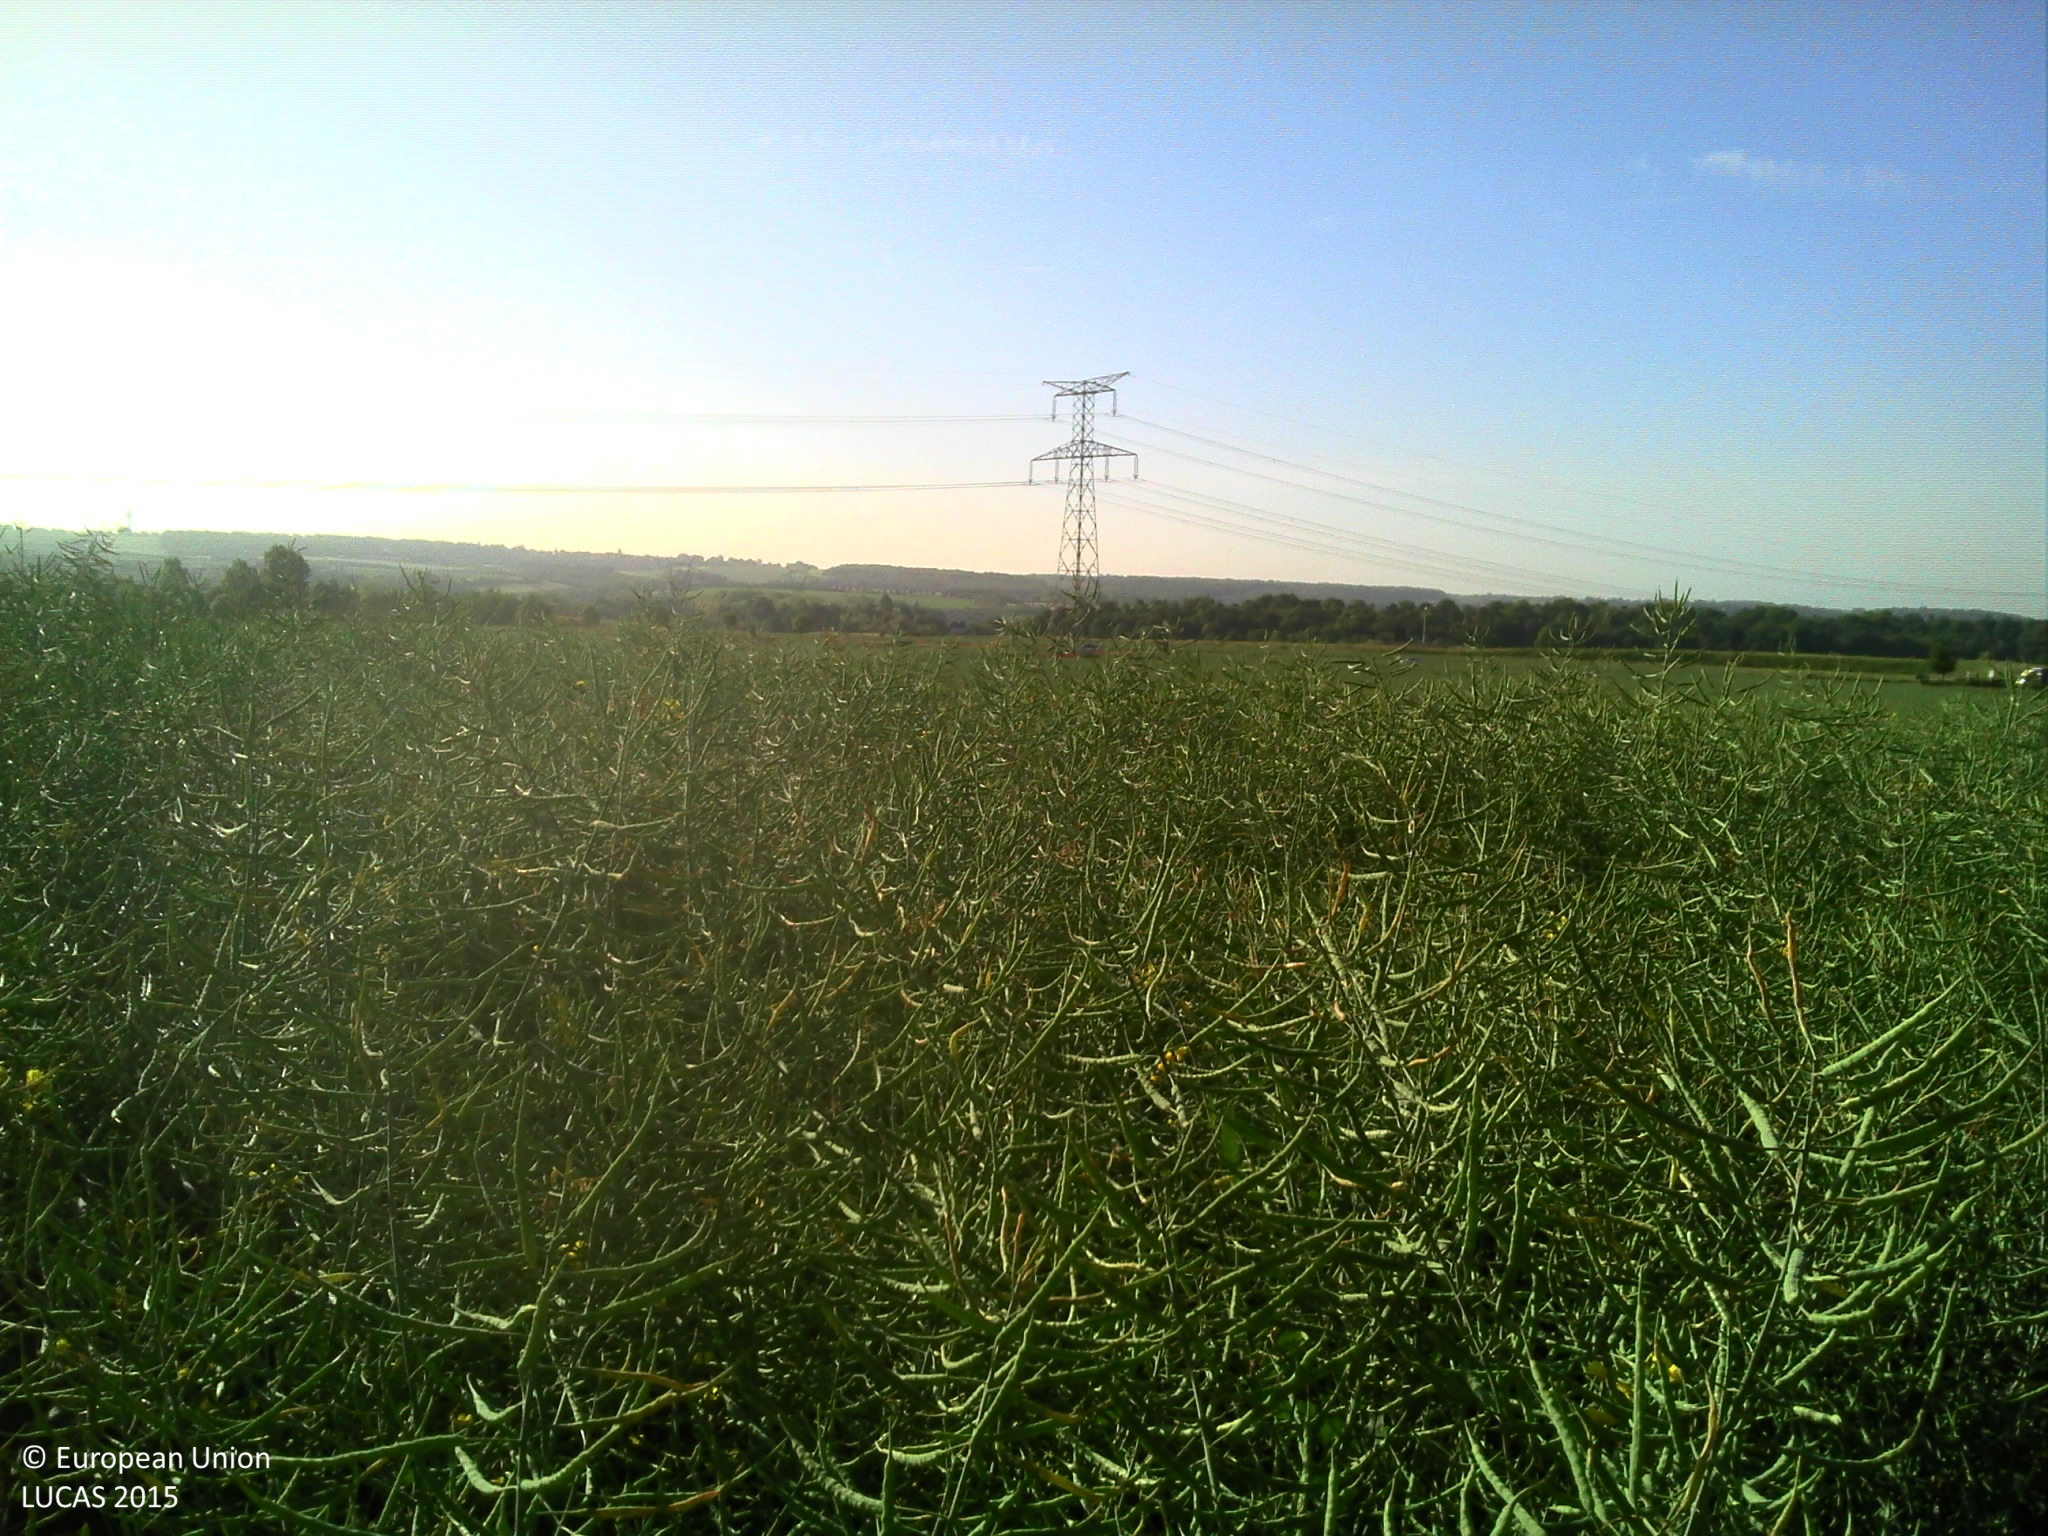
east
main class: Cropland
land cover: Rape and turnip rape
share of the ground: > 75 %
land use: Agriculture (excluding fallow land and kitchen gardens)
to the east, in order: Rape and turnip rape; Common wheat; Electric lines
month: June
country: FR
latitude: 49.8633
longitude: 2.2094
